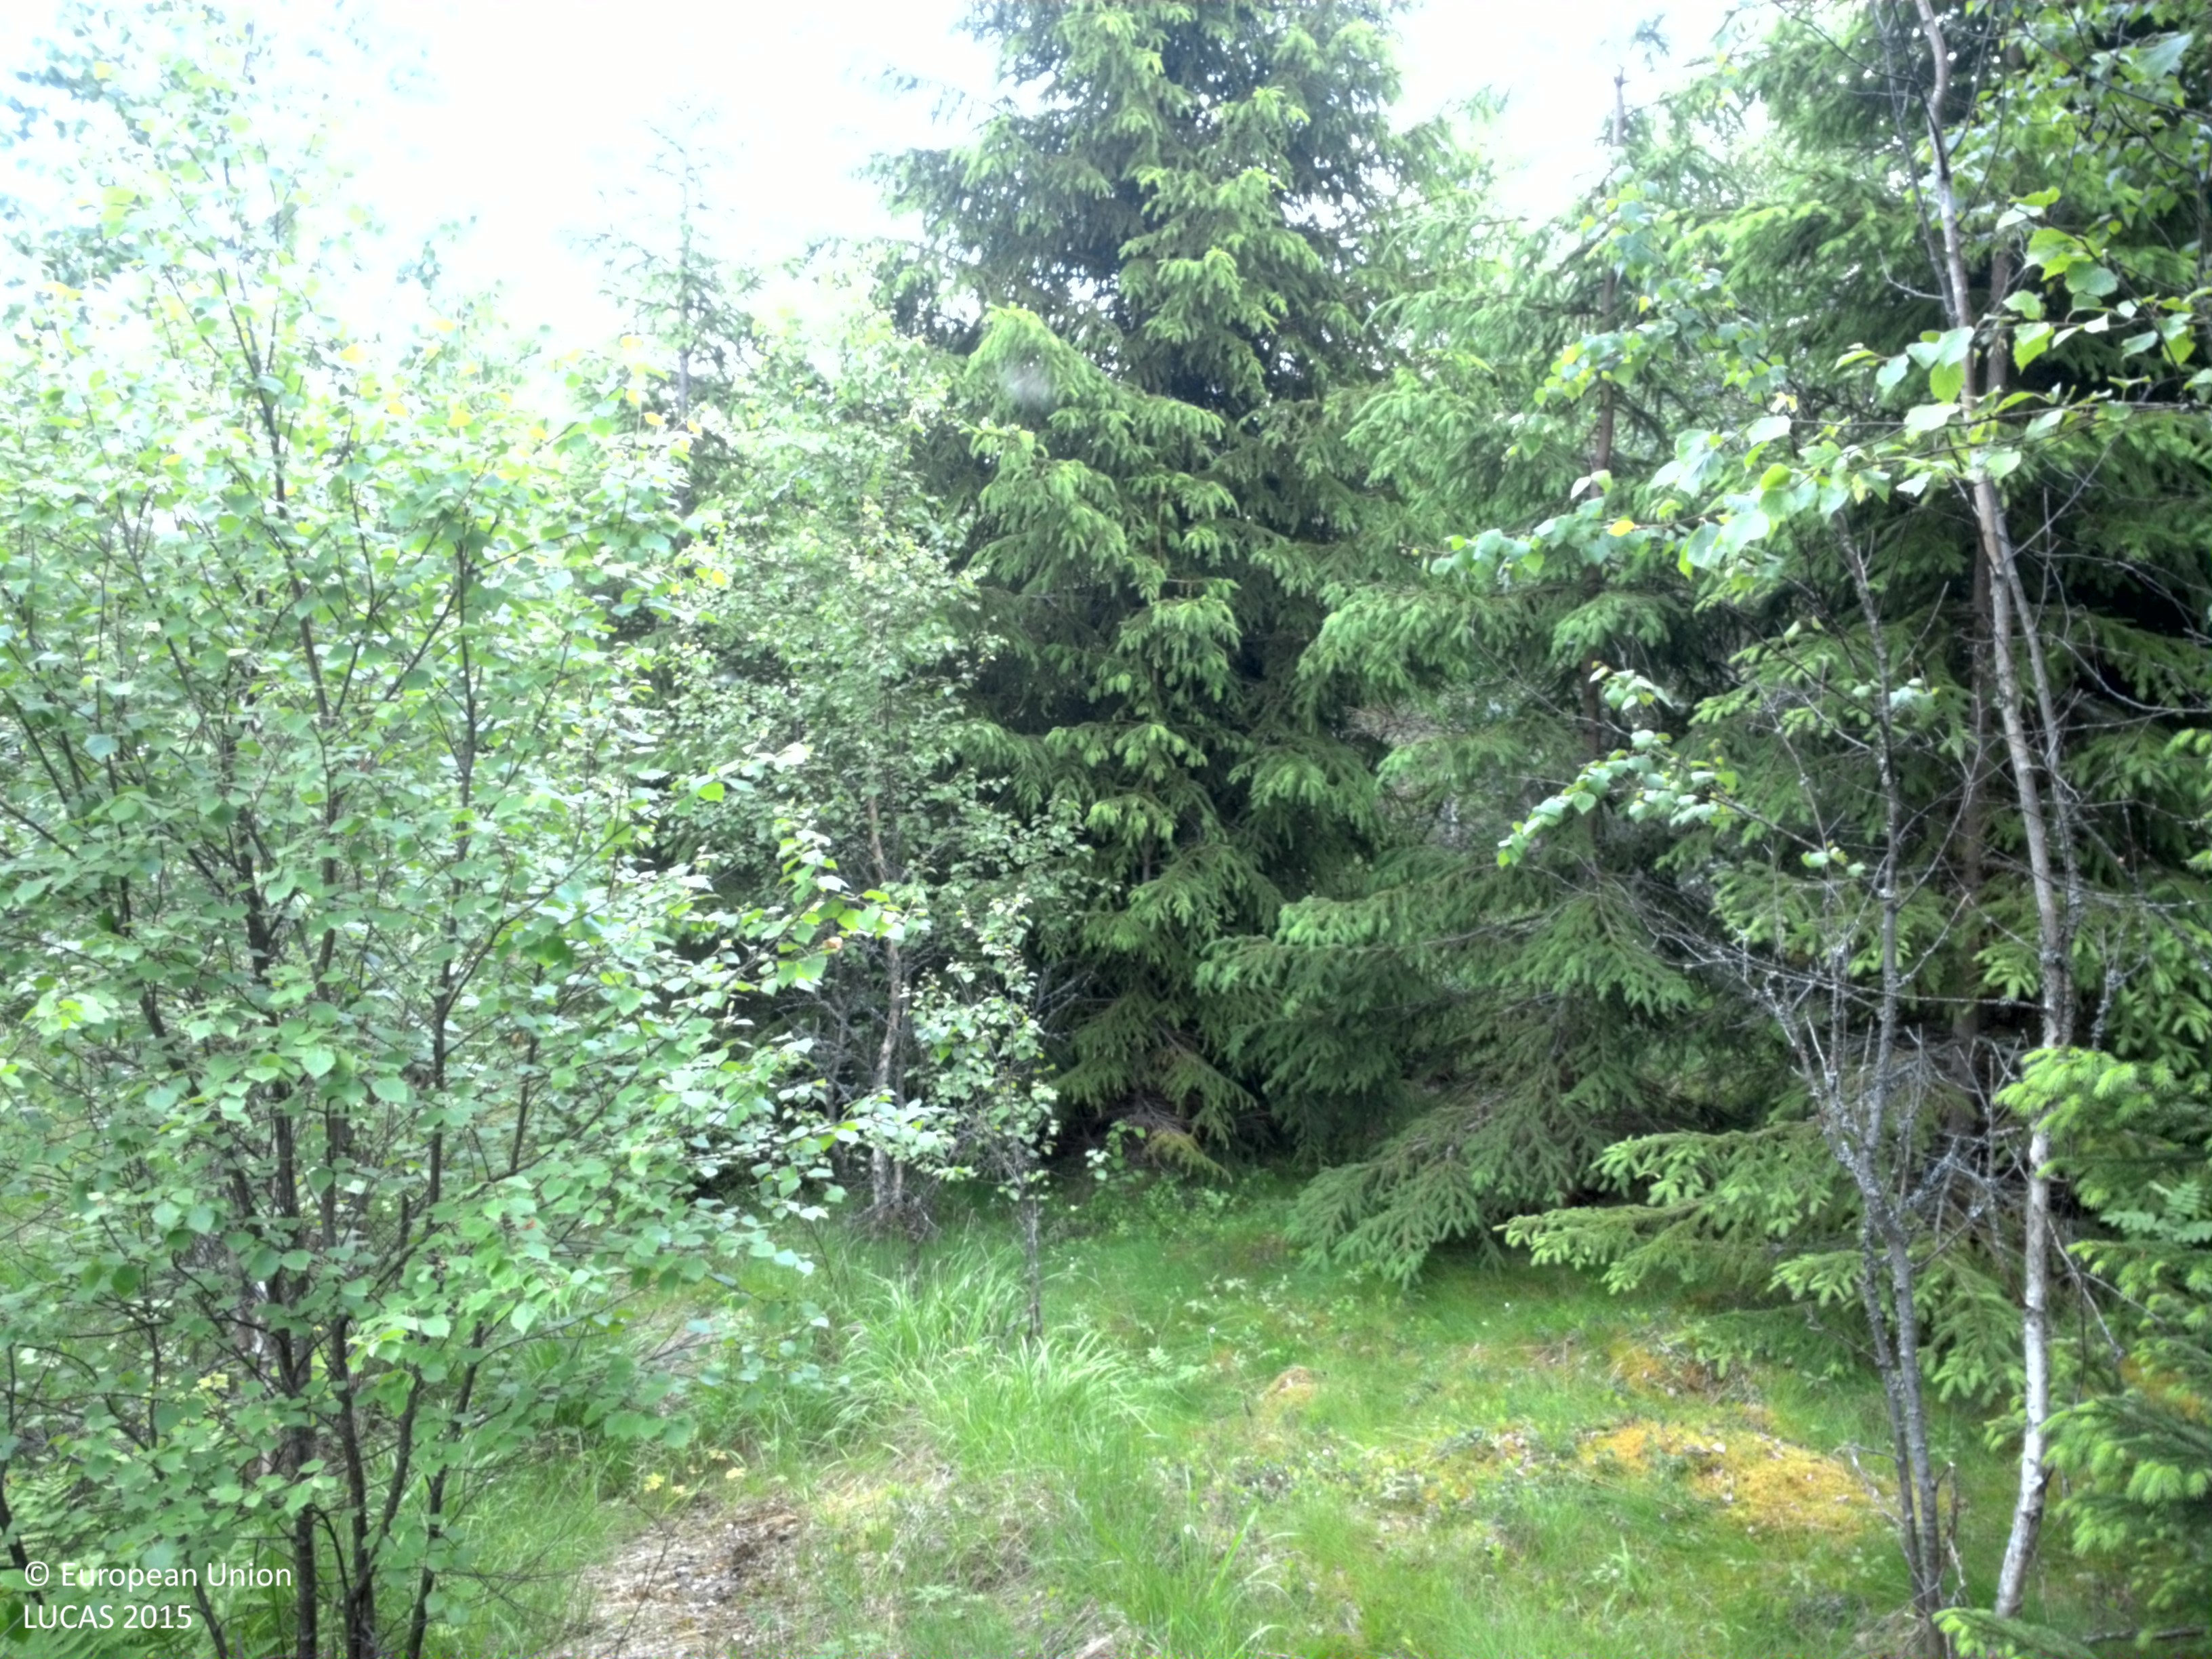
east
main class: Woodland
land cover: Spruce dominated mixed woodland
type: boreal forest
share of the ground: 25 - 50 %
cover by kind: herbaceous plants 40 %, coniferous forest trees 35 %, broadleaved forest trees 15 %, shrubs 5 %, lichens and mosses 5 %
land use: Forestry
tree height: > 5 m
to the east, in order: Spruce dominated mixed woodland; Tracks; Spruce dominated mixed woodland; Broadleaved woodland; Spruce dominated mixed woodland; Shrubland with sparse tree cover
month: June
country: SE
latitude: 59.9691
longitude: 17.0319
